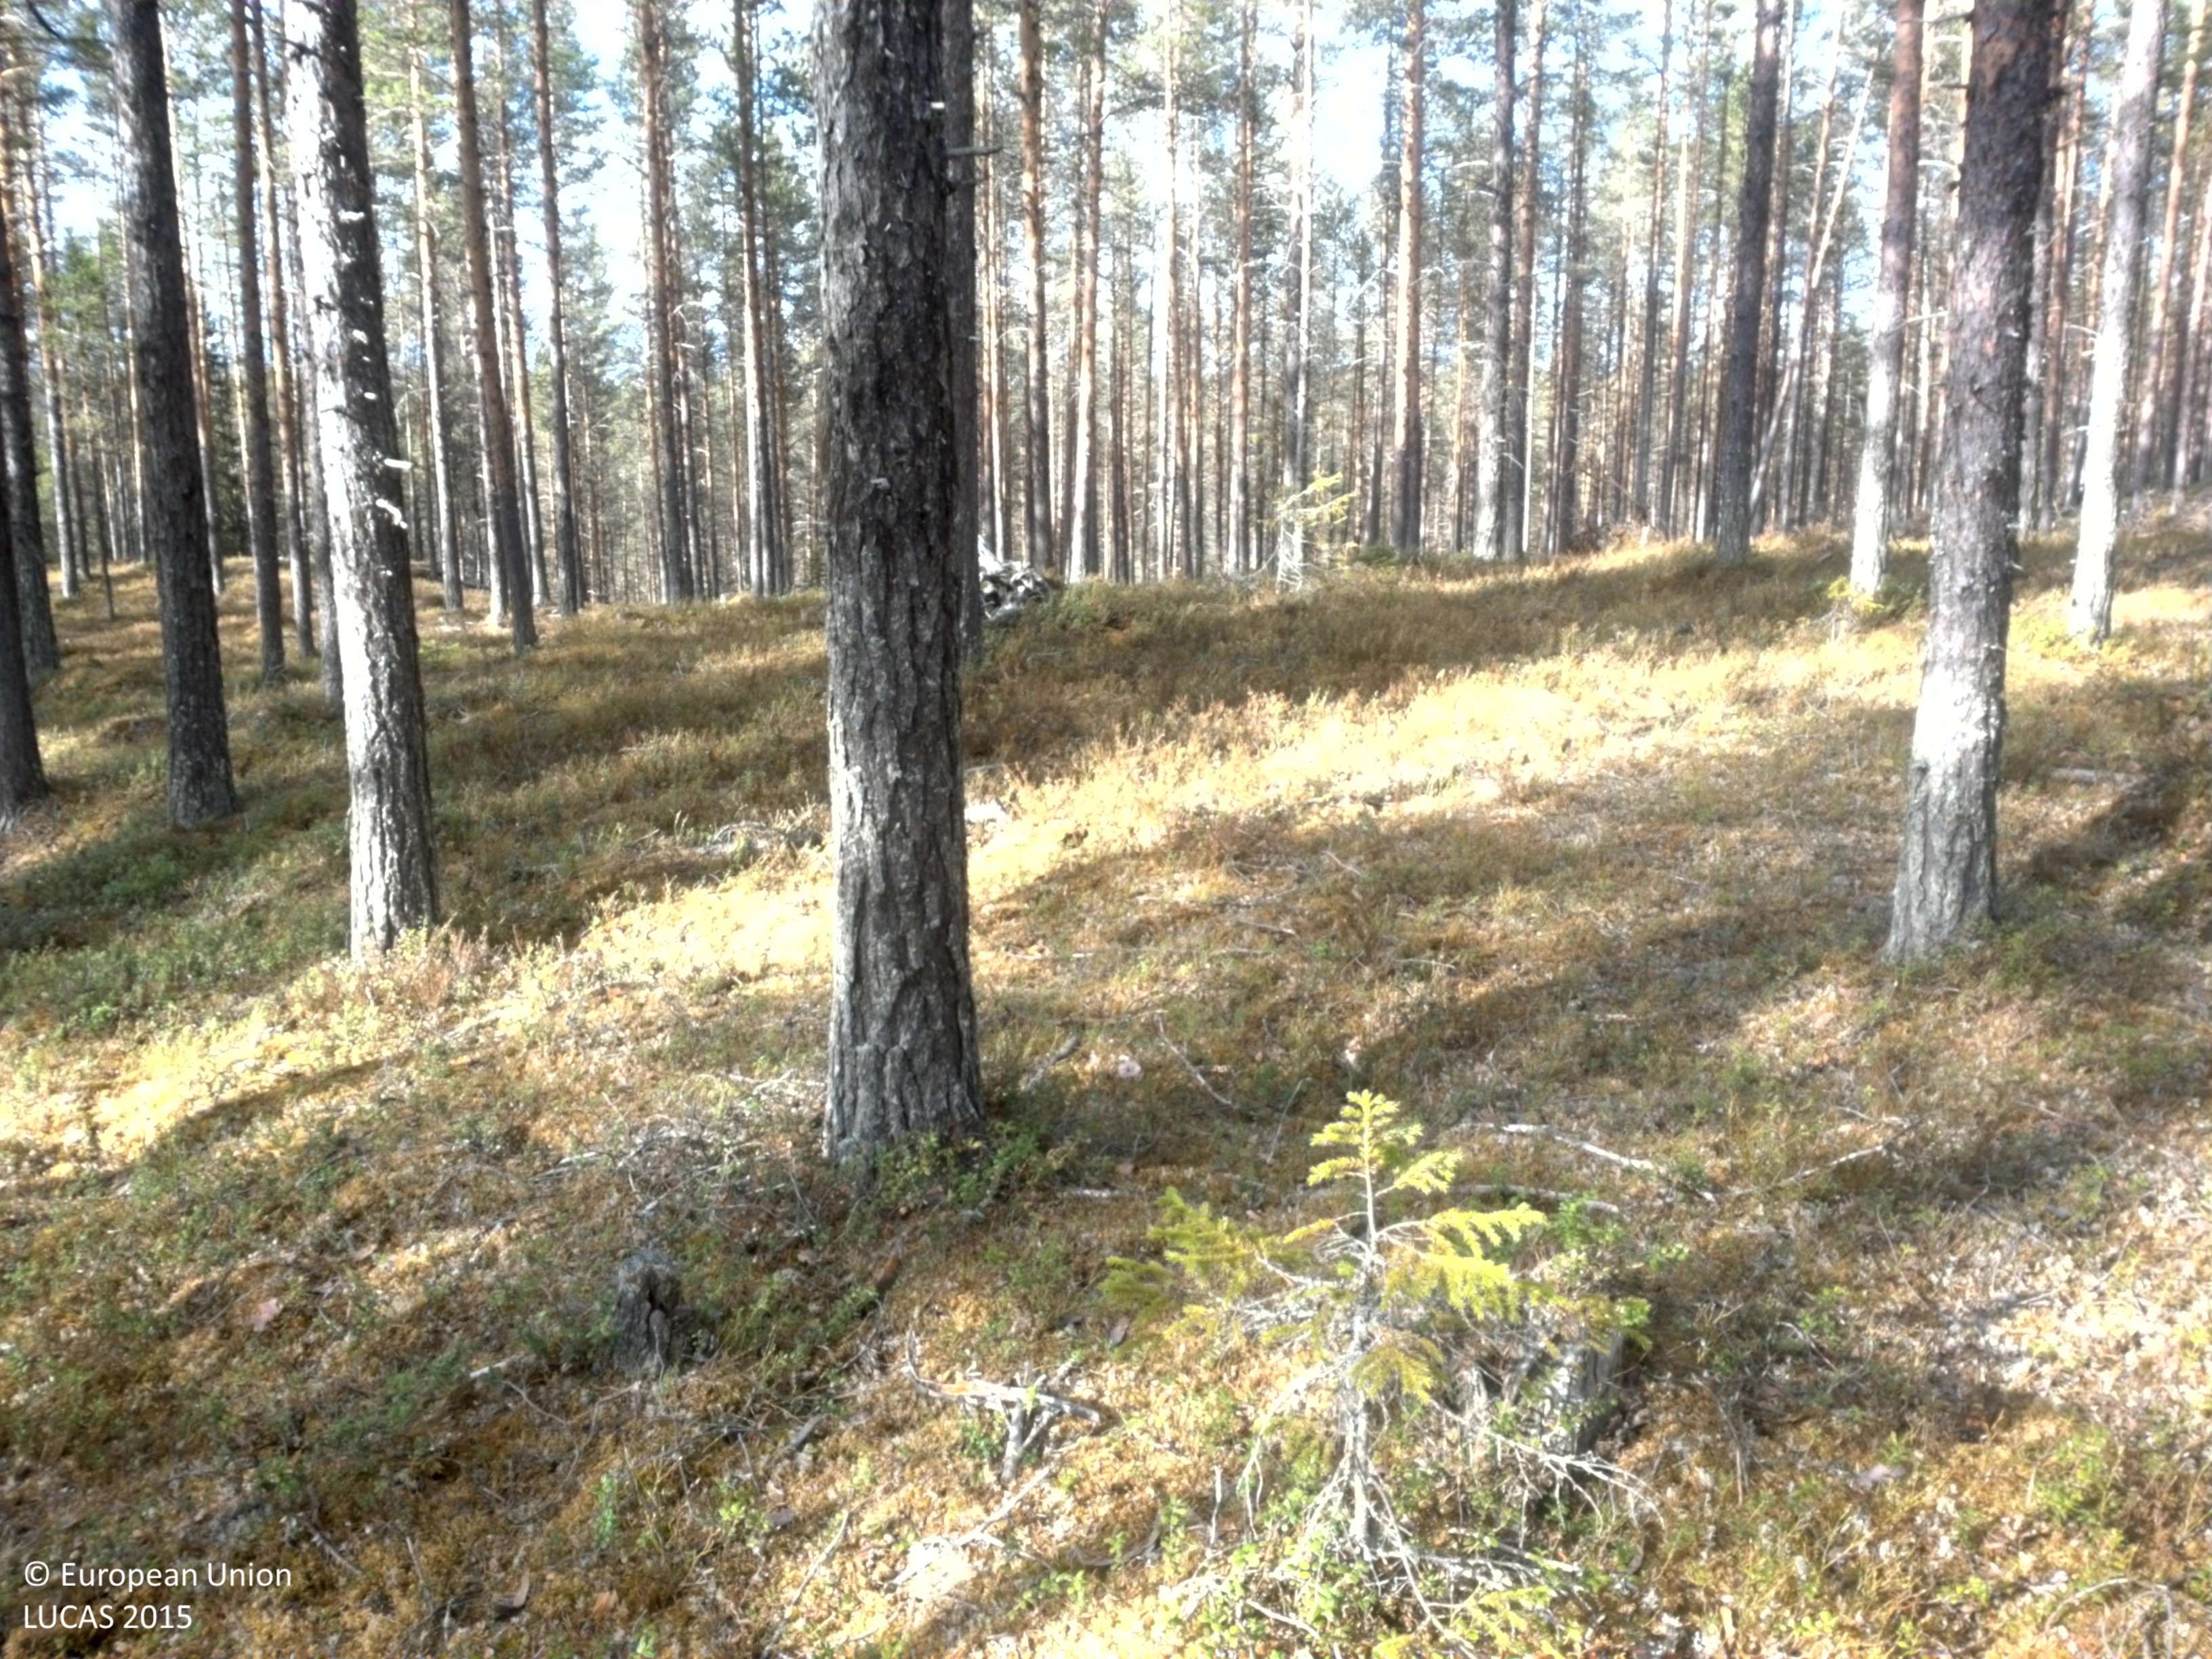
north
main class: Woodland
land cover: Pine dominated coniferous woodland
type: boreal forest
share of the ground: 25 - 50 %
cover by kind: lichens and mosses 45 %, coniferous forest trees 35 %, herbaceous plants 20 %
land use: Forestry
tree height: > 5 m
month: June
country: SE
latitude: 64.2785
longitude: 18.1681
